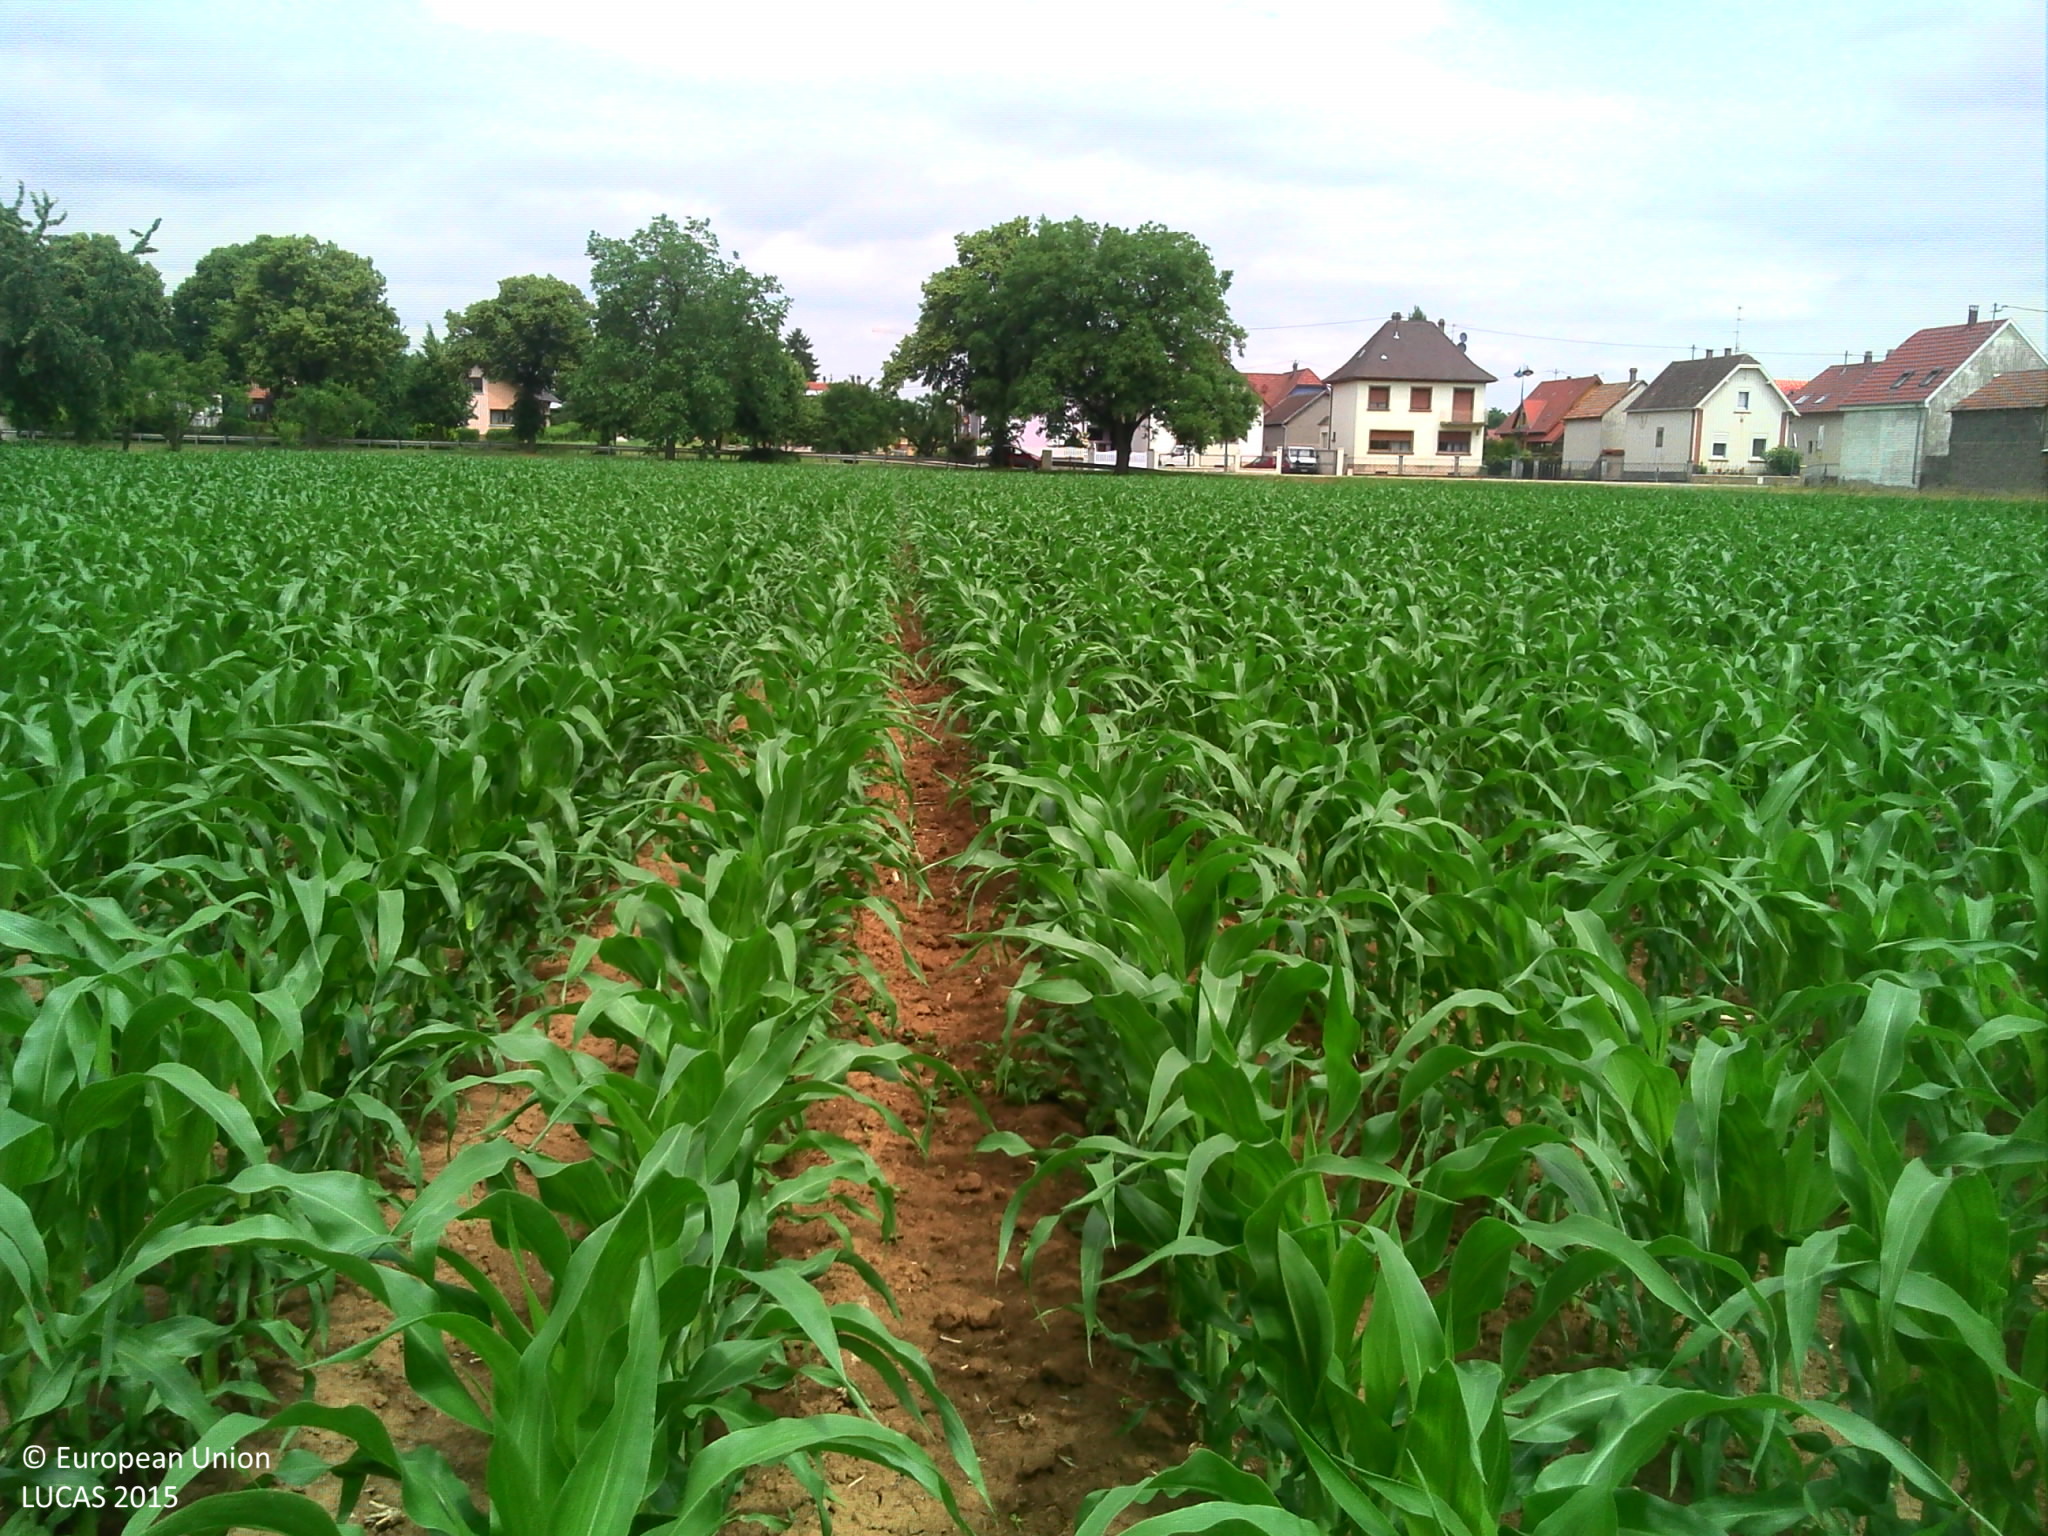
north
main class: Cropland
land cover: Maize
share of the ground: 50 - 75 %
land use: Agriculture (excluding fallow land and kitchen gardens)
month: June
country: FR
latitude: 48.5198
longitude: 7.5232
